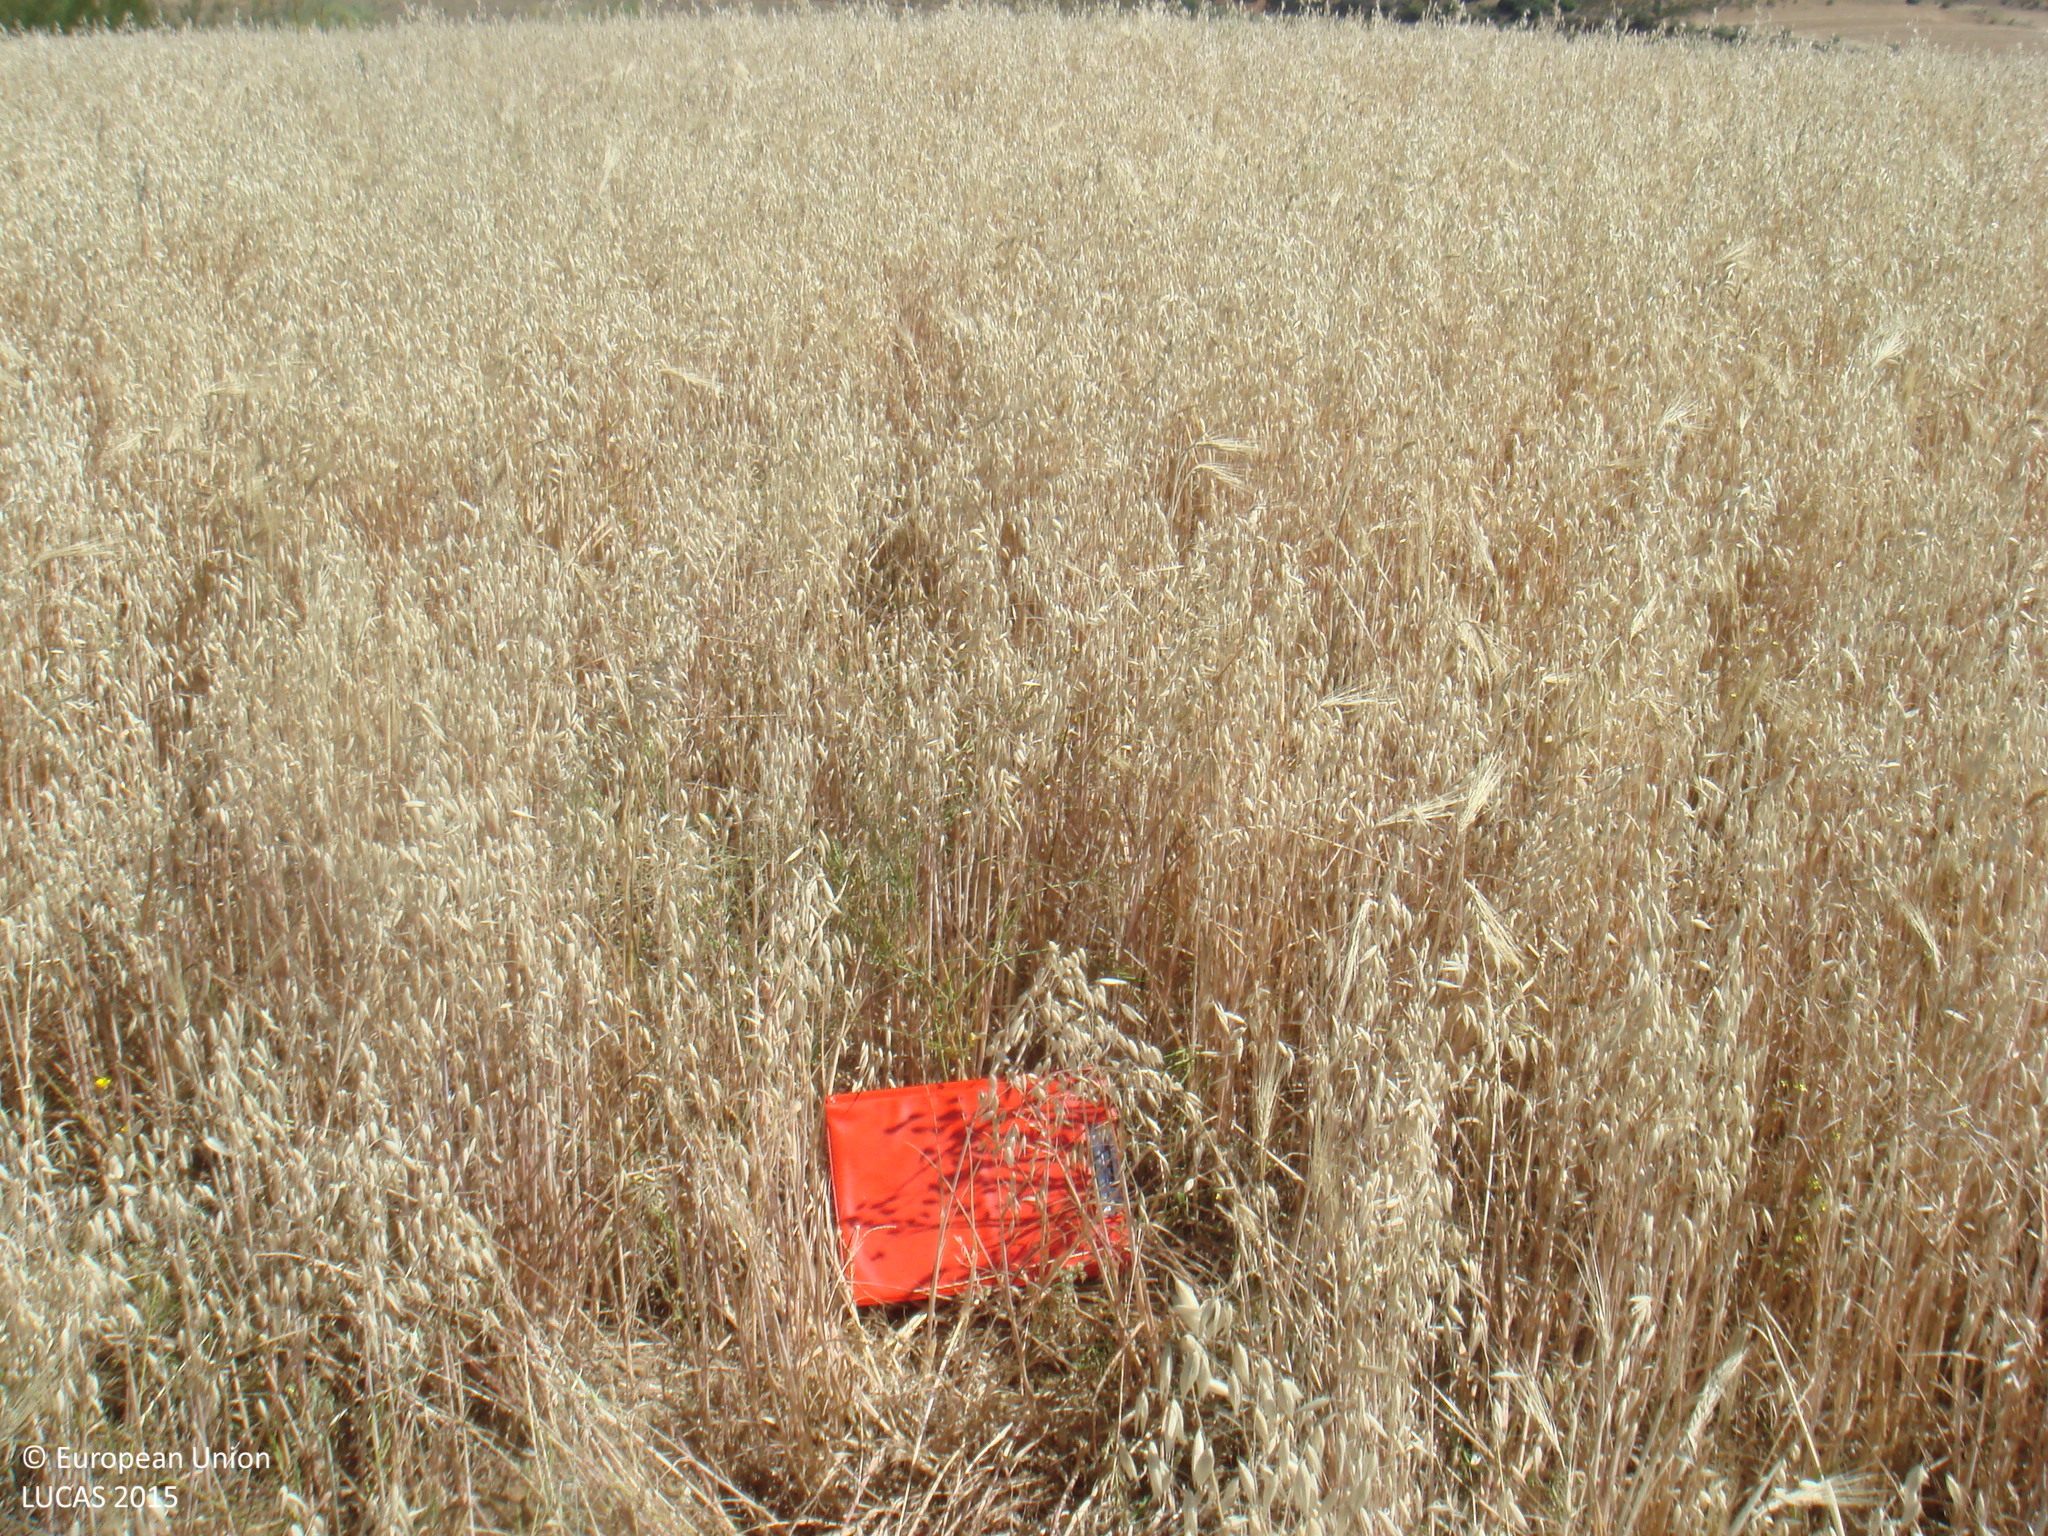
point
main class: Cropland
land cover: Mixed cereals for fodder
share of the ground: > 75 %
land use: Agriculture (excluding fallow land and kitchen gardens)
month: May
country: ES
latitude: 38.6755
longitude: -5.1711
